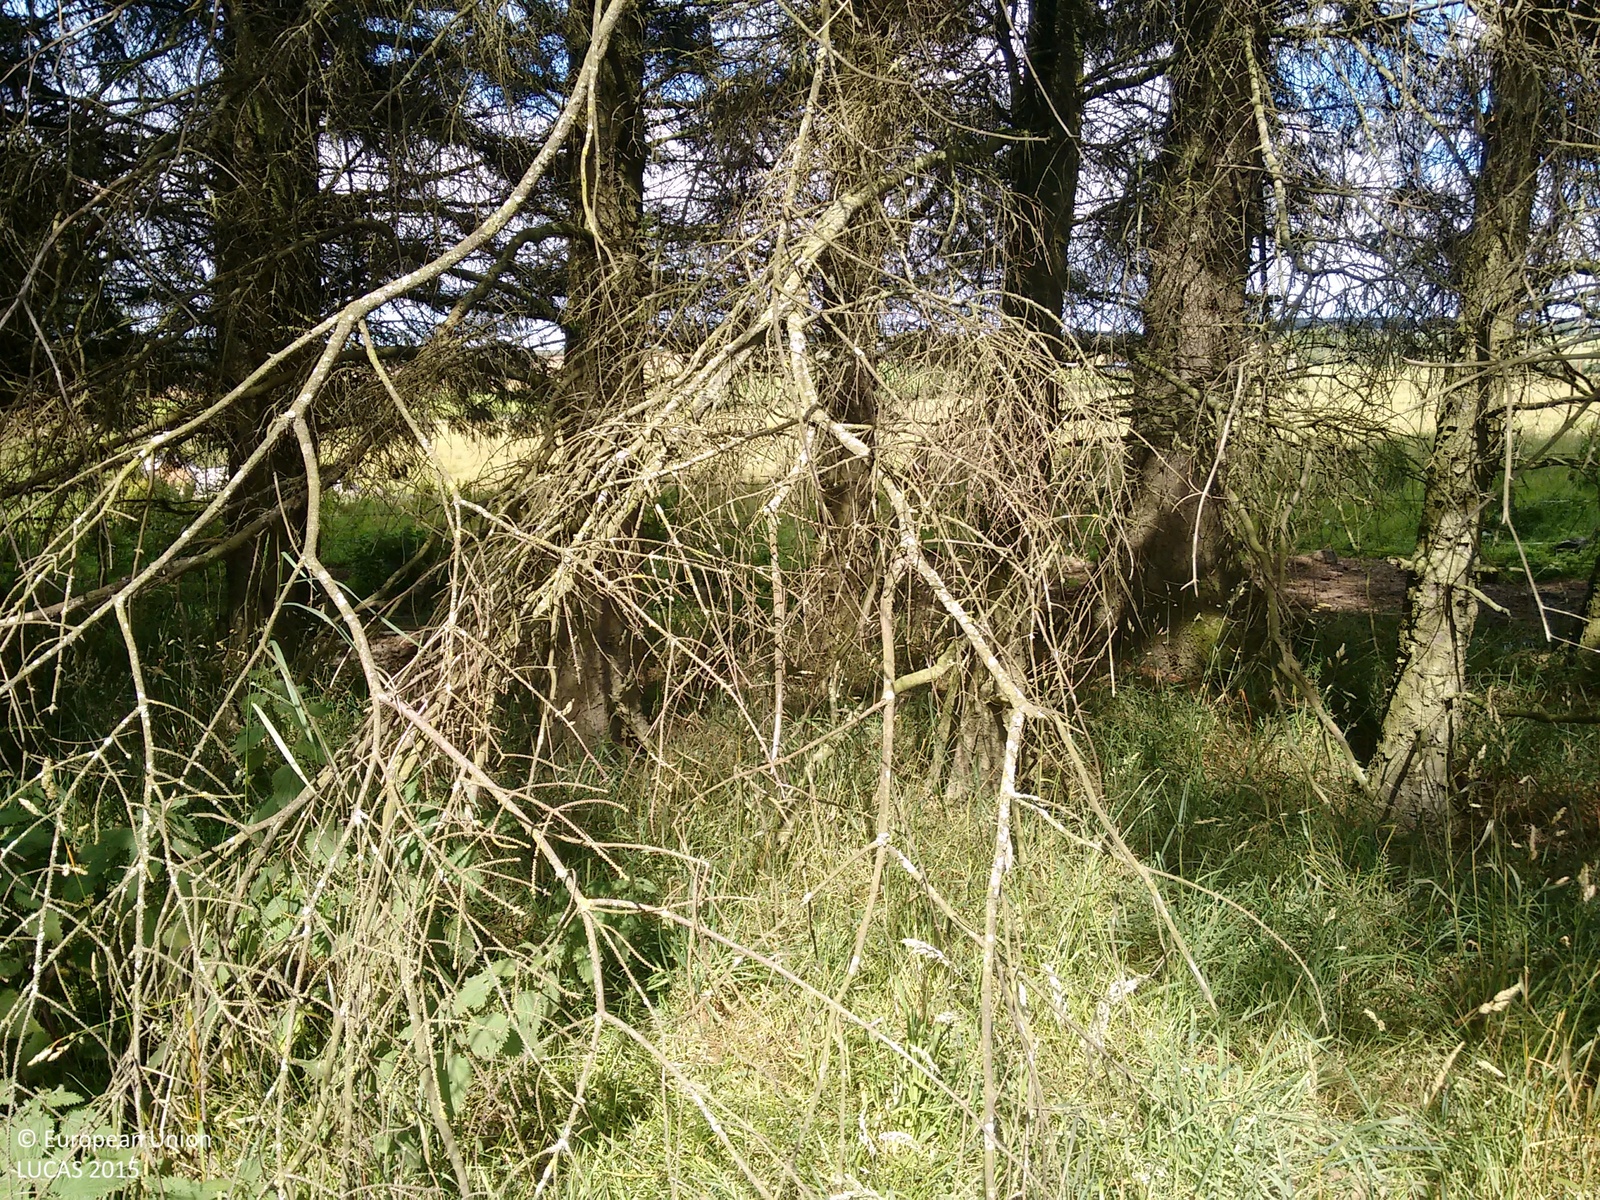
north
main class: Woodland
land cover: Spruce dominated coniferous woodland
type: exotic forest
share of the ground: > 75 %
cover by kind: coniferous forest trees 70 %, herbaceous plants 10 %, broadleaved forest trees 5 %, shrubs 5 %
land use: Agriculture (excluding fallow land and kitchen gardens)
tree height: > 5 m
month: August
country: GB
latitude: 57.5679
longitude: -2.9838
